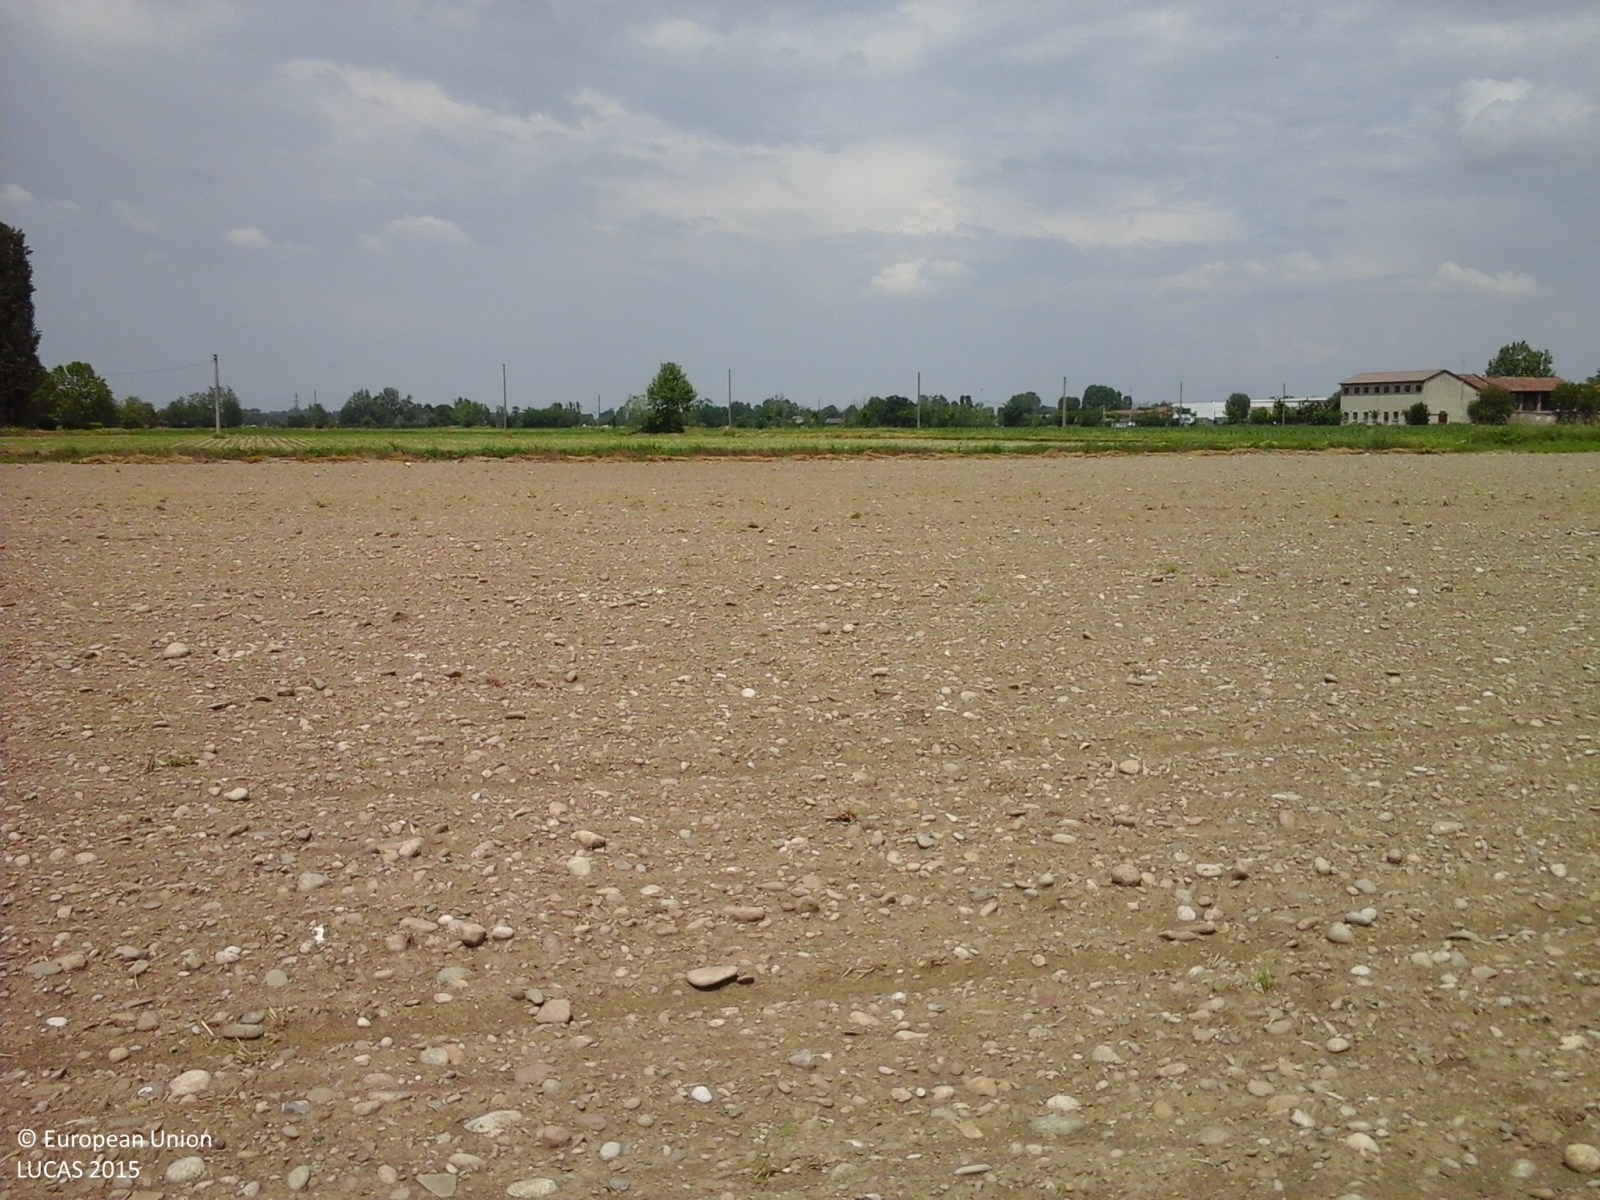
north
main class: Cropland
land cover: Maize
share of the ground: < 10 %
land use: Agriculture (excluding fallow land and kitchen gardens)
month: May
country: IT
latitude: 45.4674
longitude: 9.5531
